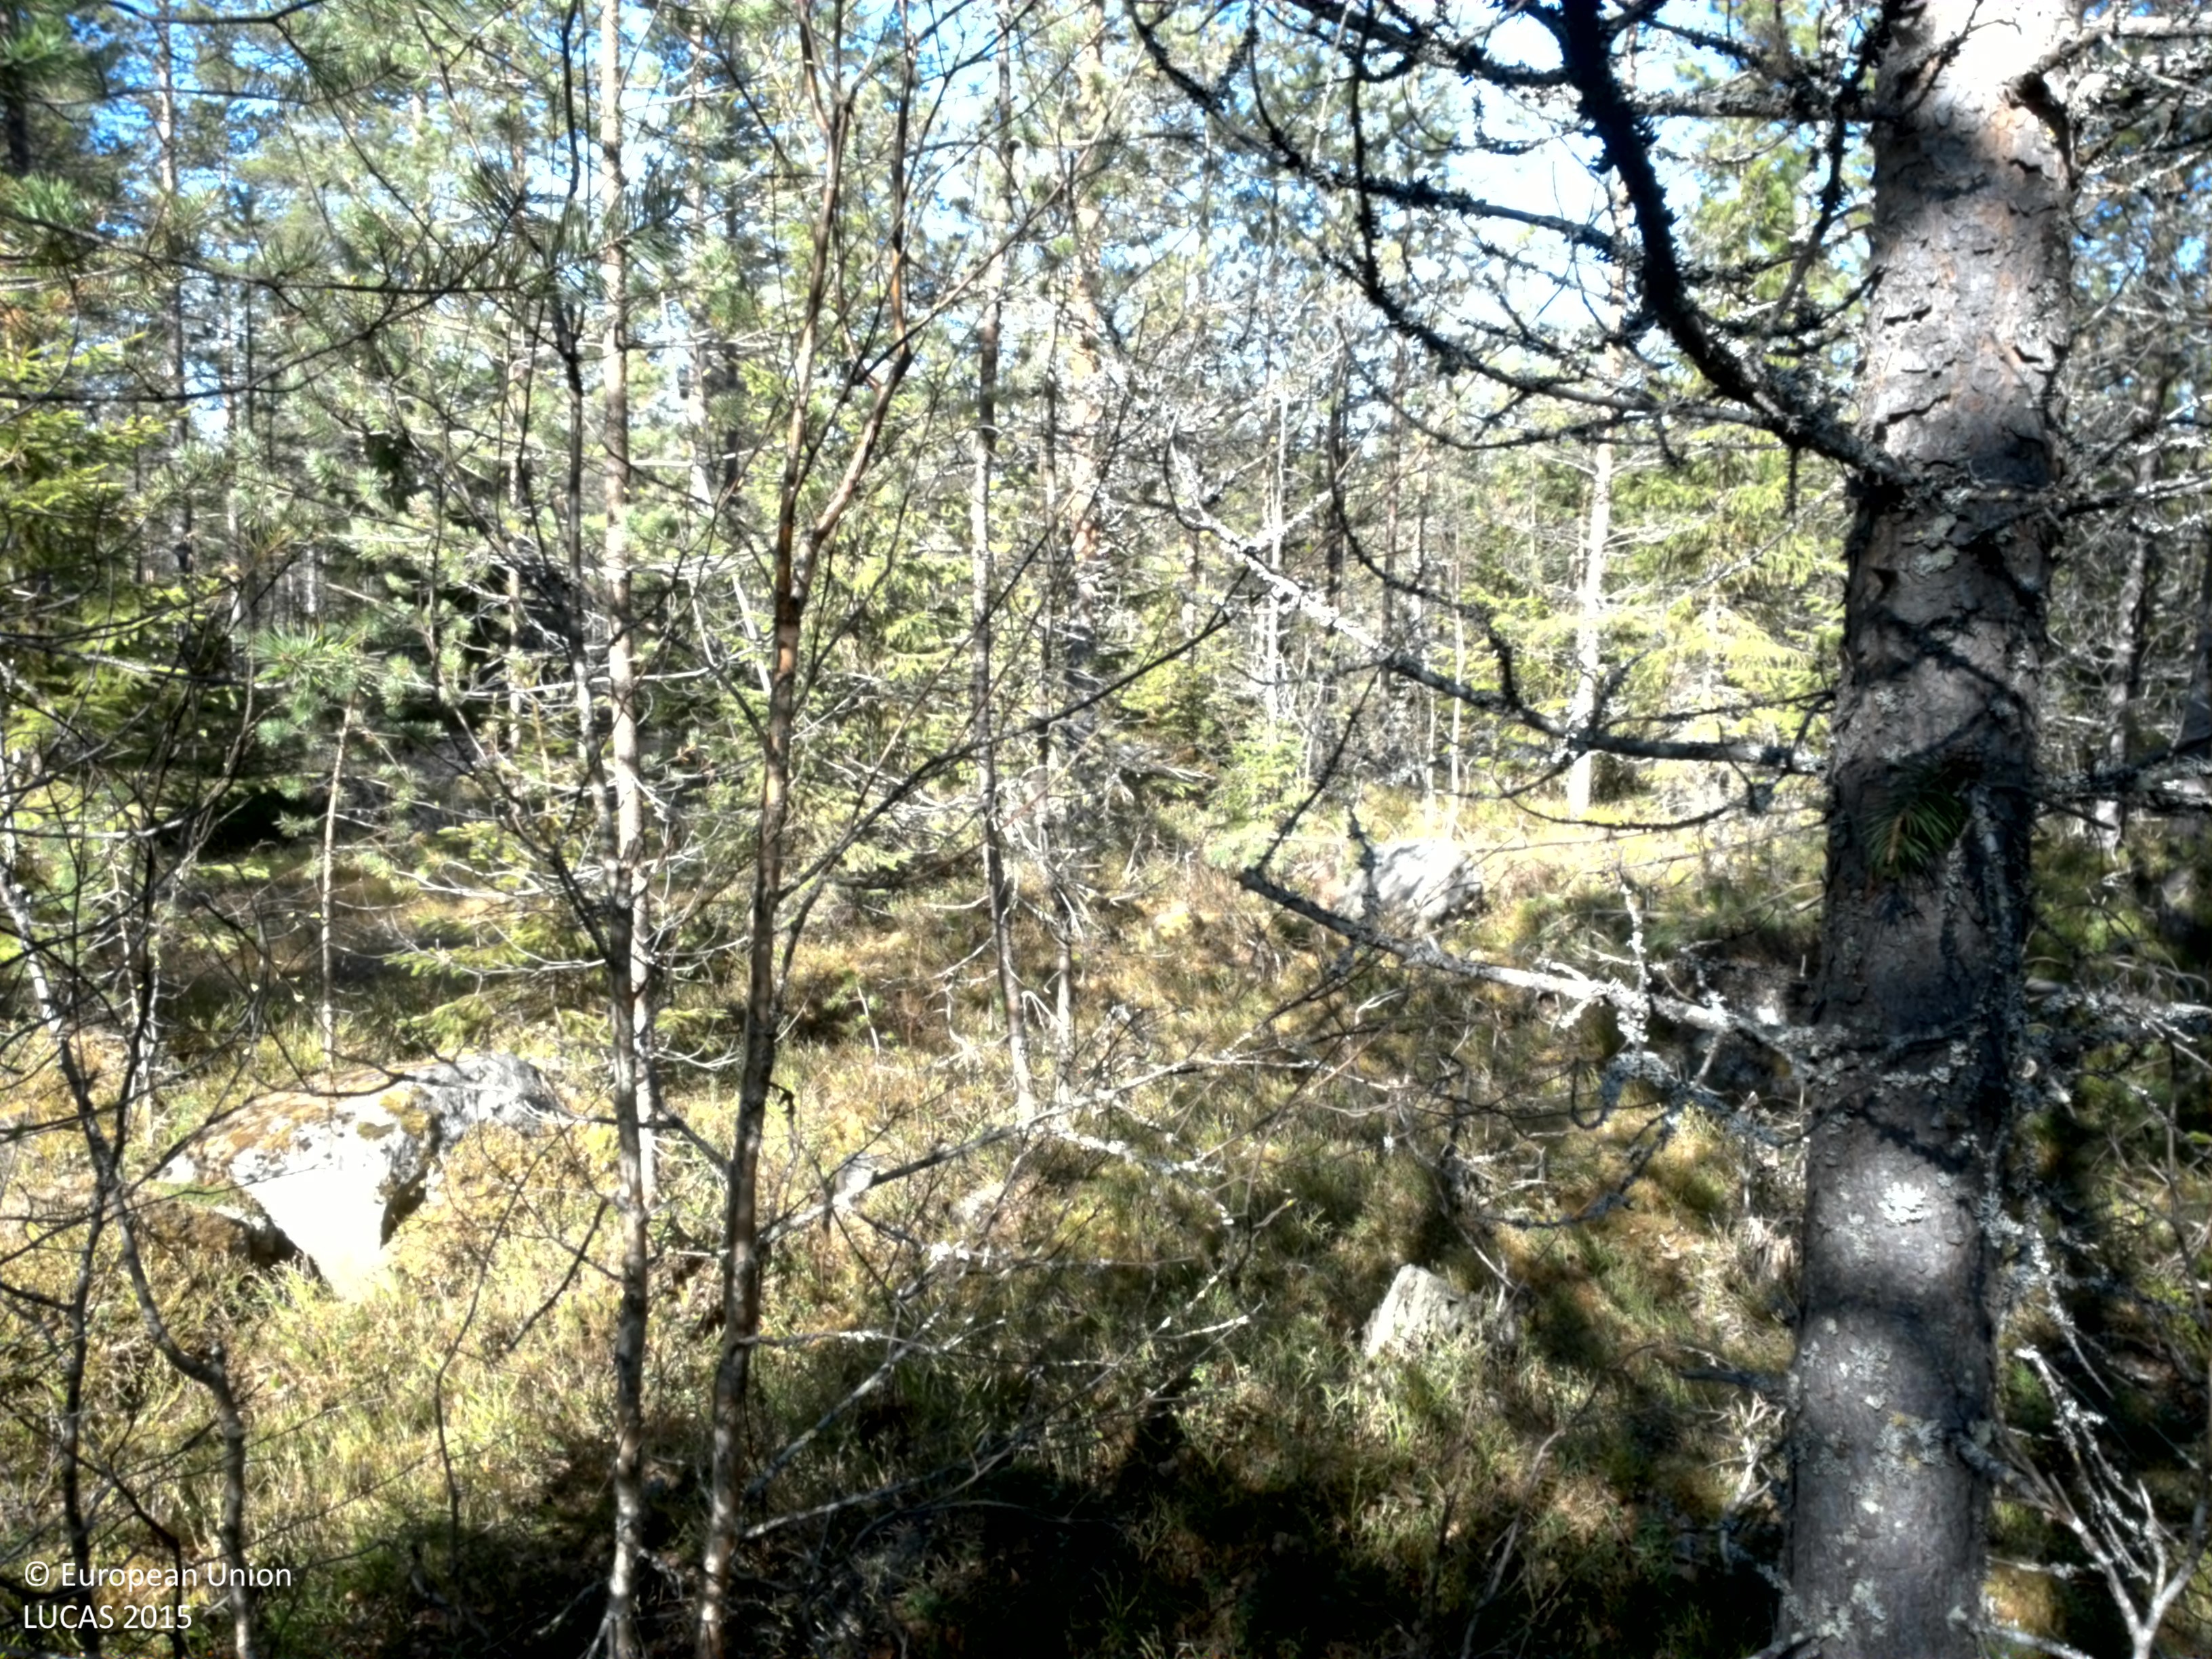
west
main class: Woodland
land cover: Pine dominated coniferous woodland
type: boreal forest
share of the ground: > 75 %
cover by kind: coniferous forest trees 80 %, shrubs 20 %
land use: Forestry
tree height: > 5 m
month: May
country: SE
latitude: 65.9081
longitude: 24.0292
